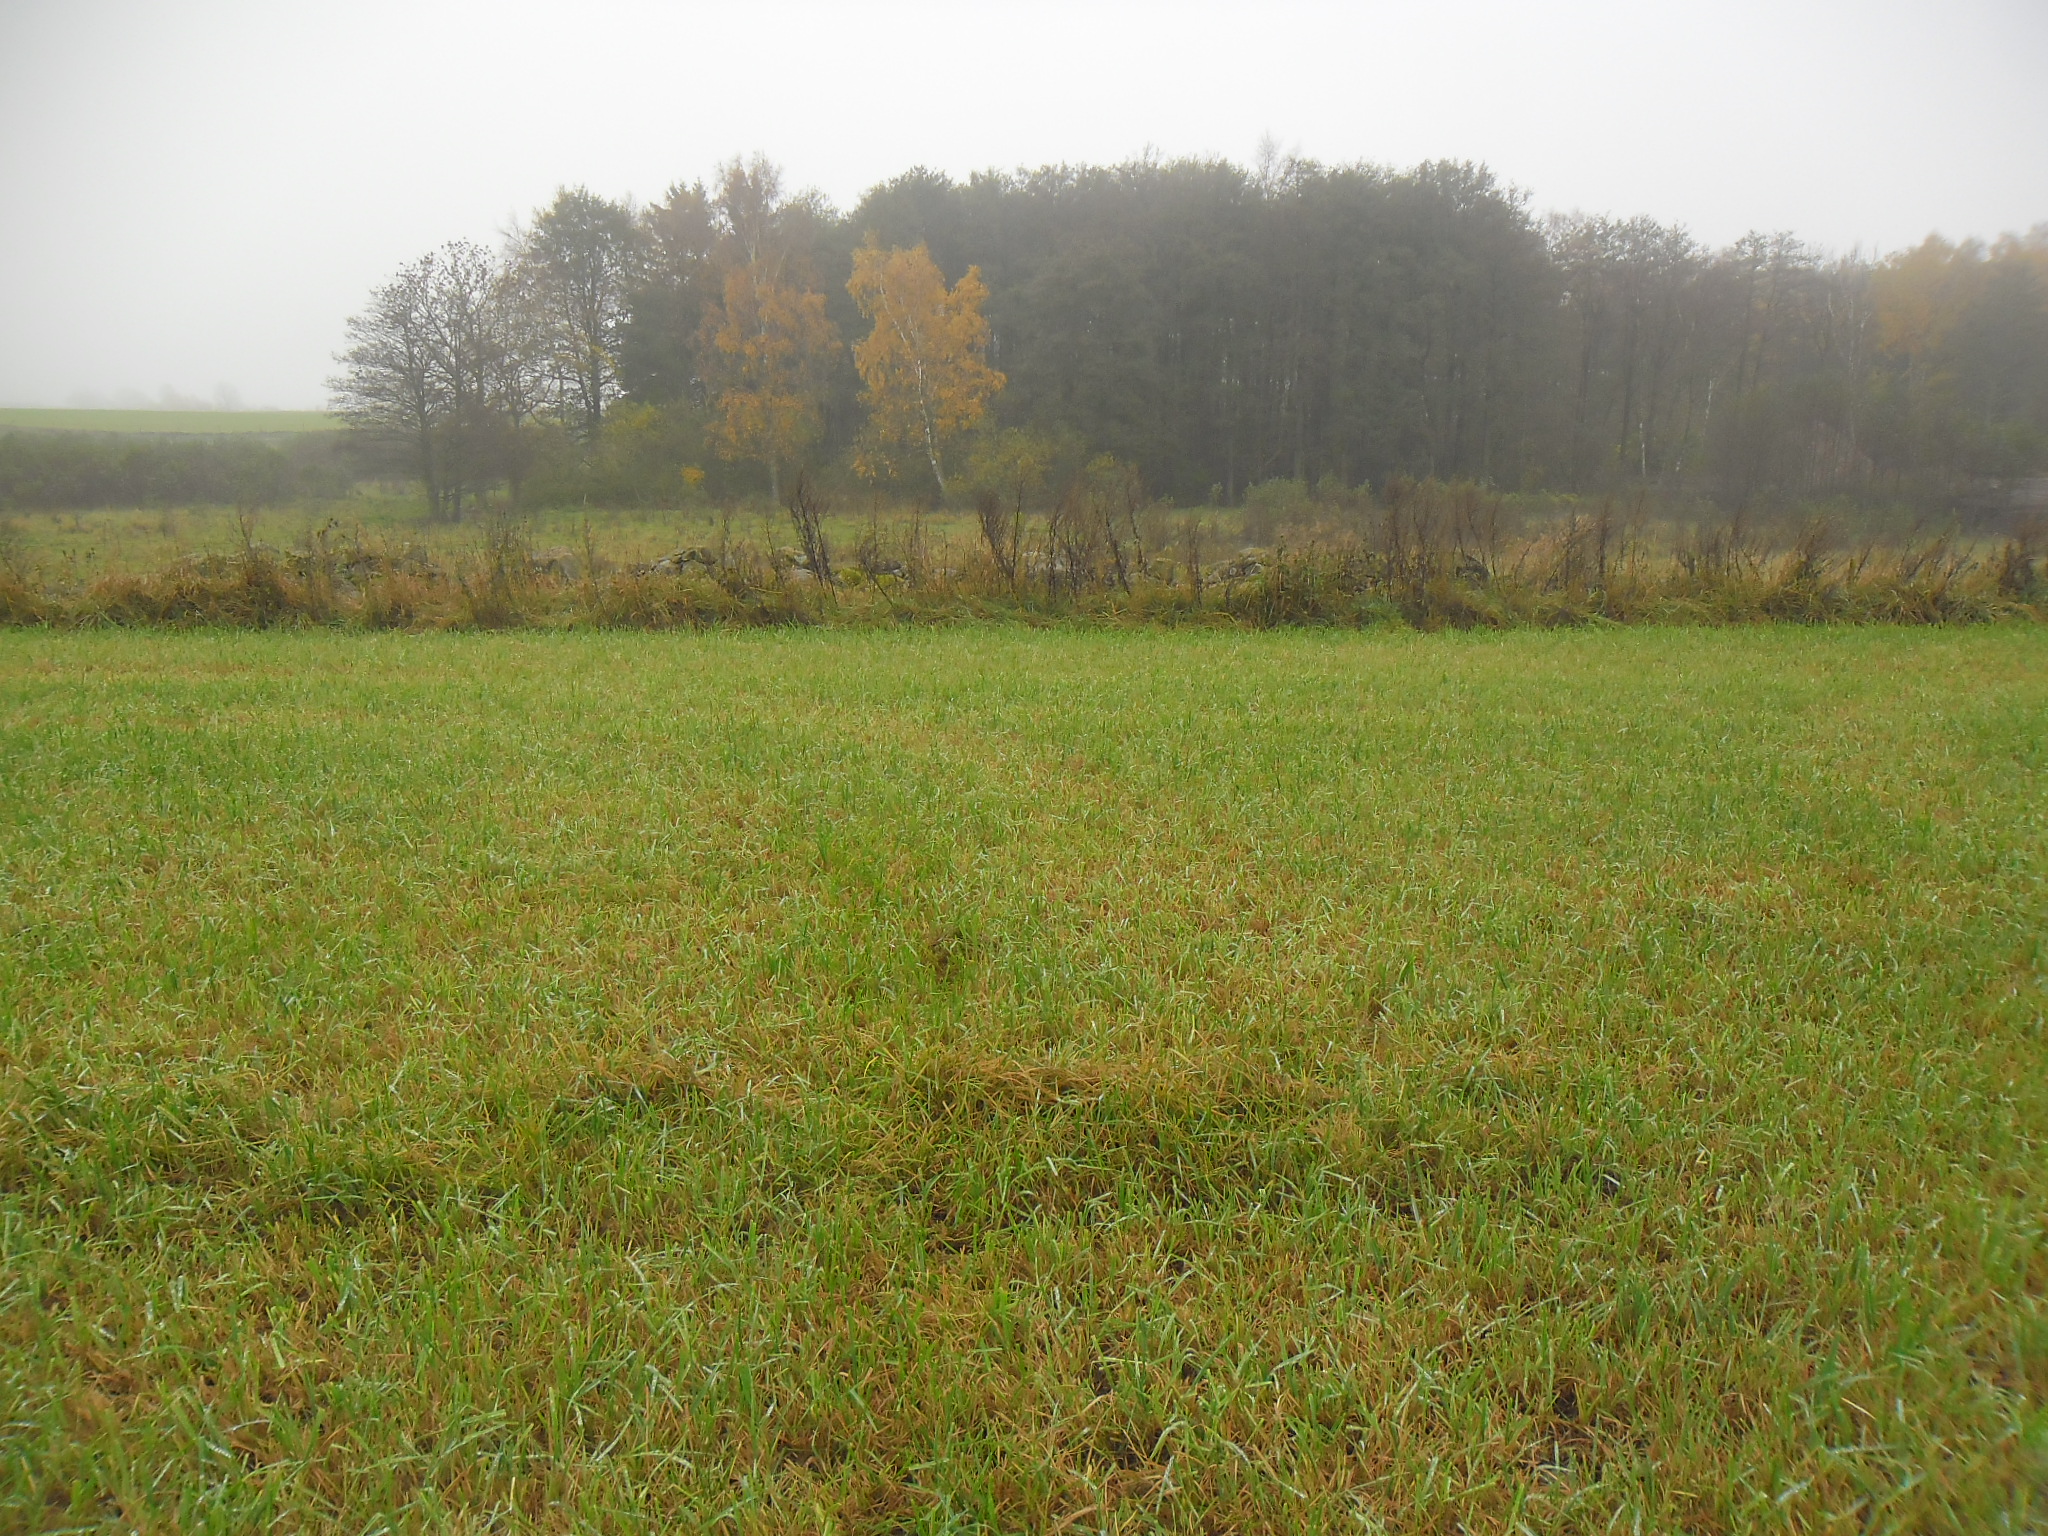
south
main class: Grassland
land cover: Grassland without tree/shrub cover
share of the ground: > 75 %
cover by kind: herbaceous plants 100 %
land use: Agriculture (excluding fallow land and kitchen gardens)
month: November
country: SE
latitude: 56.3731
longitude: 12.7983
